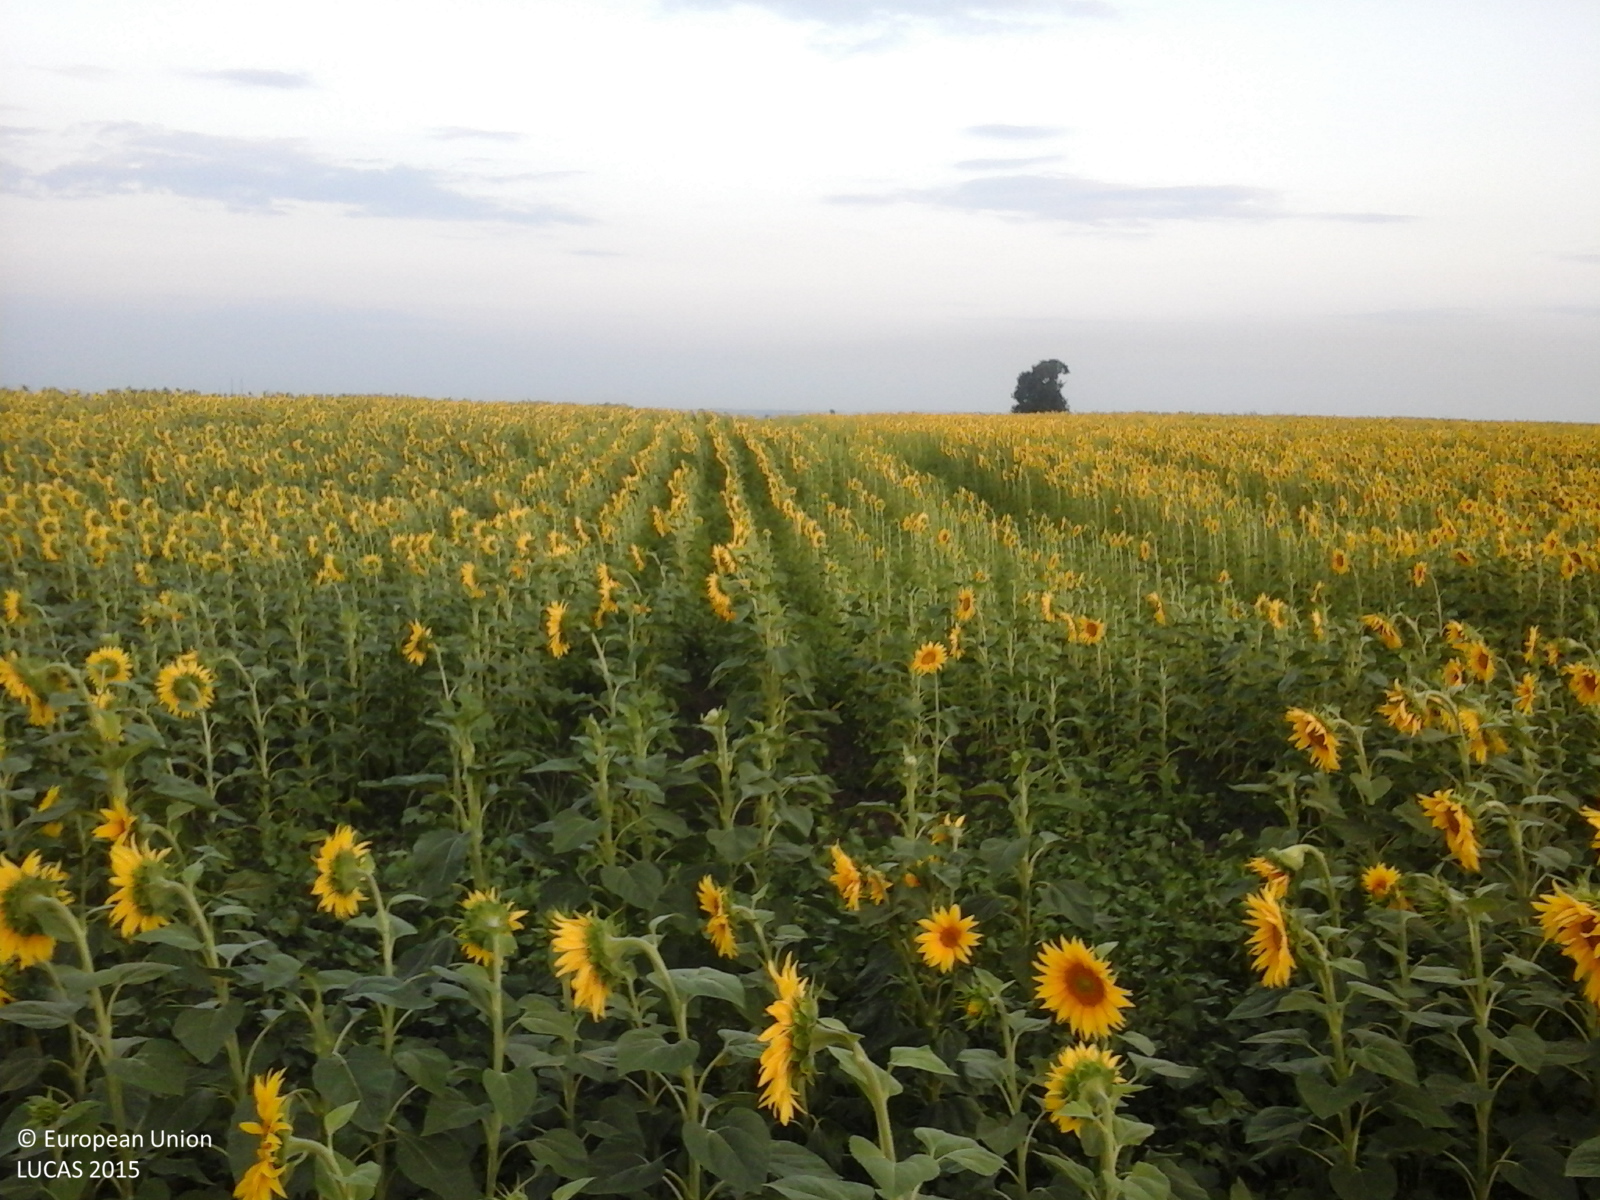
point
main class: Cropland
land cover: Sunflower
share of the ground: > 75 %
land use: Agriculture (excluding fallow land and kitchen gardens)
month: July
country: RO
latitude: 43.9327
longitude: 25.9539
